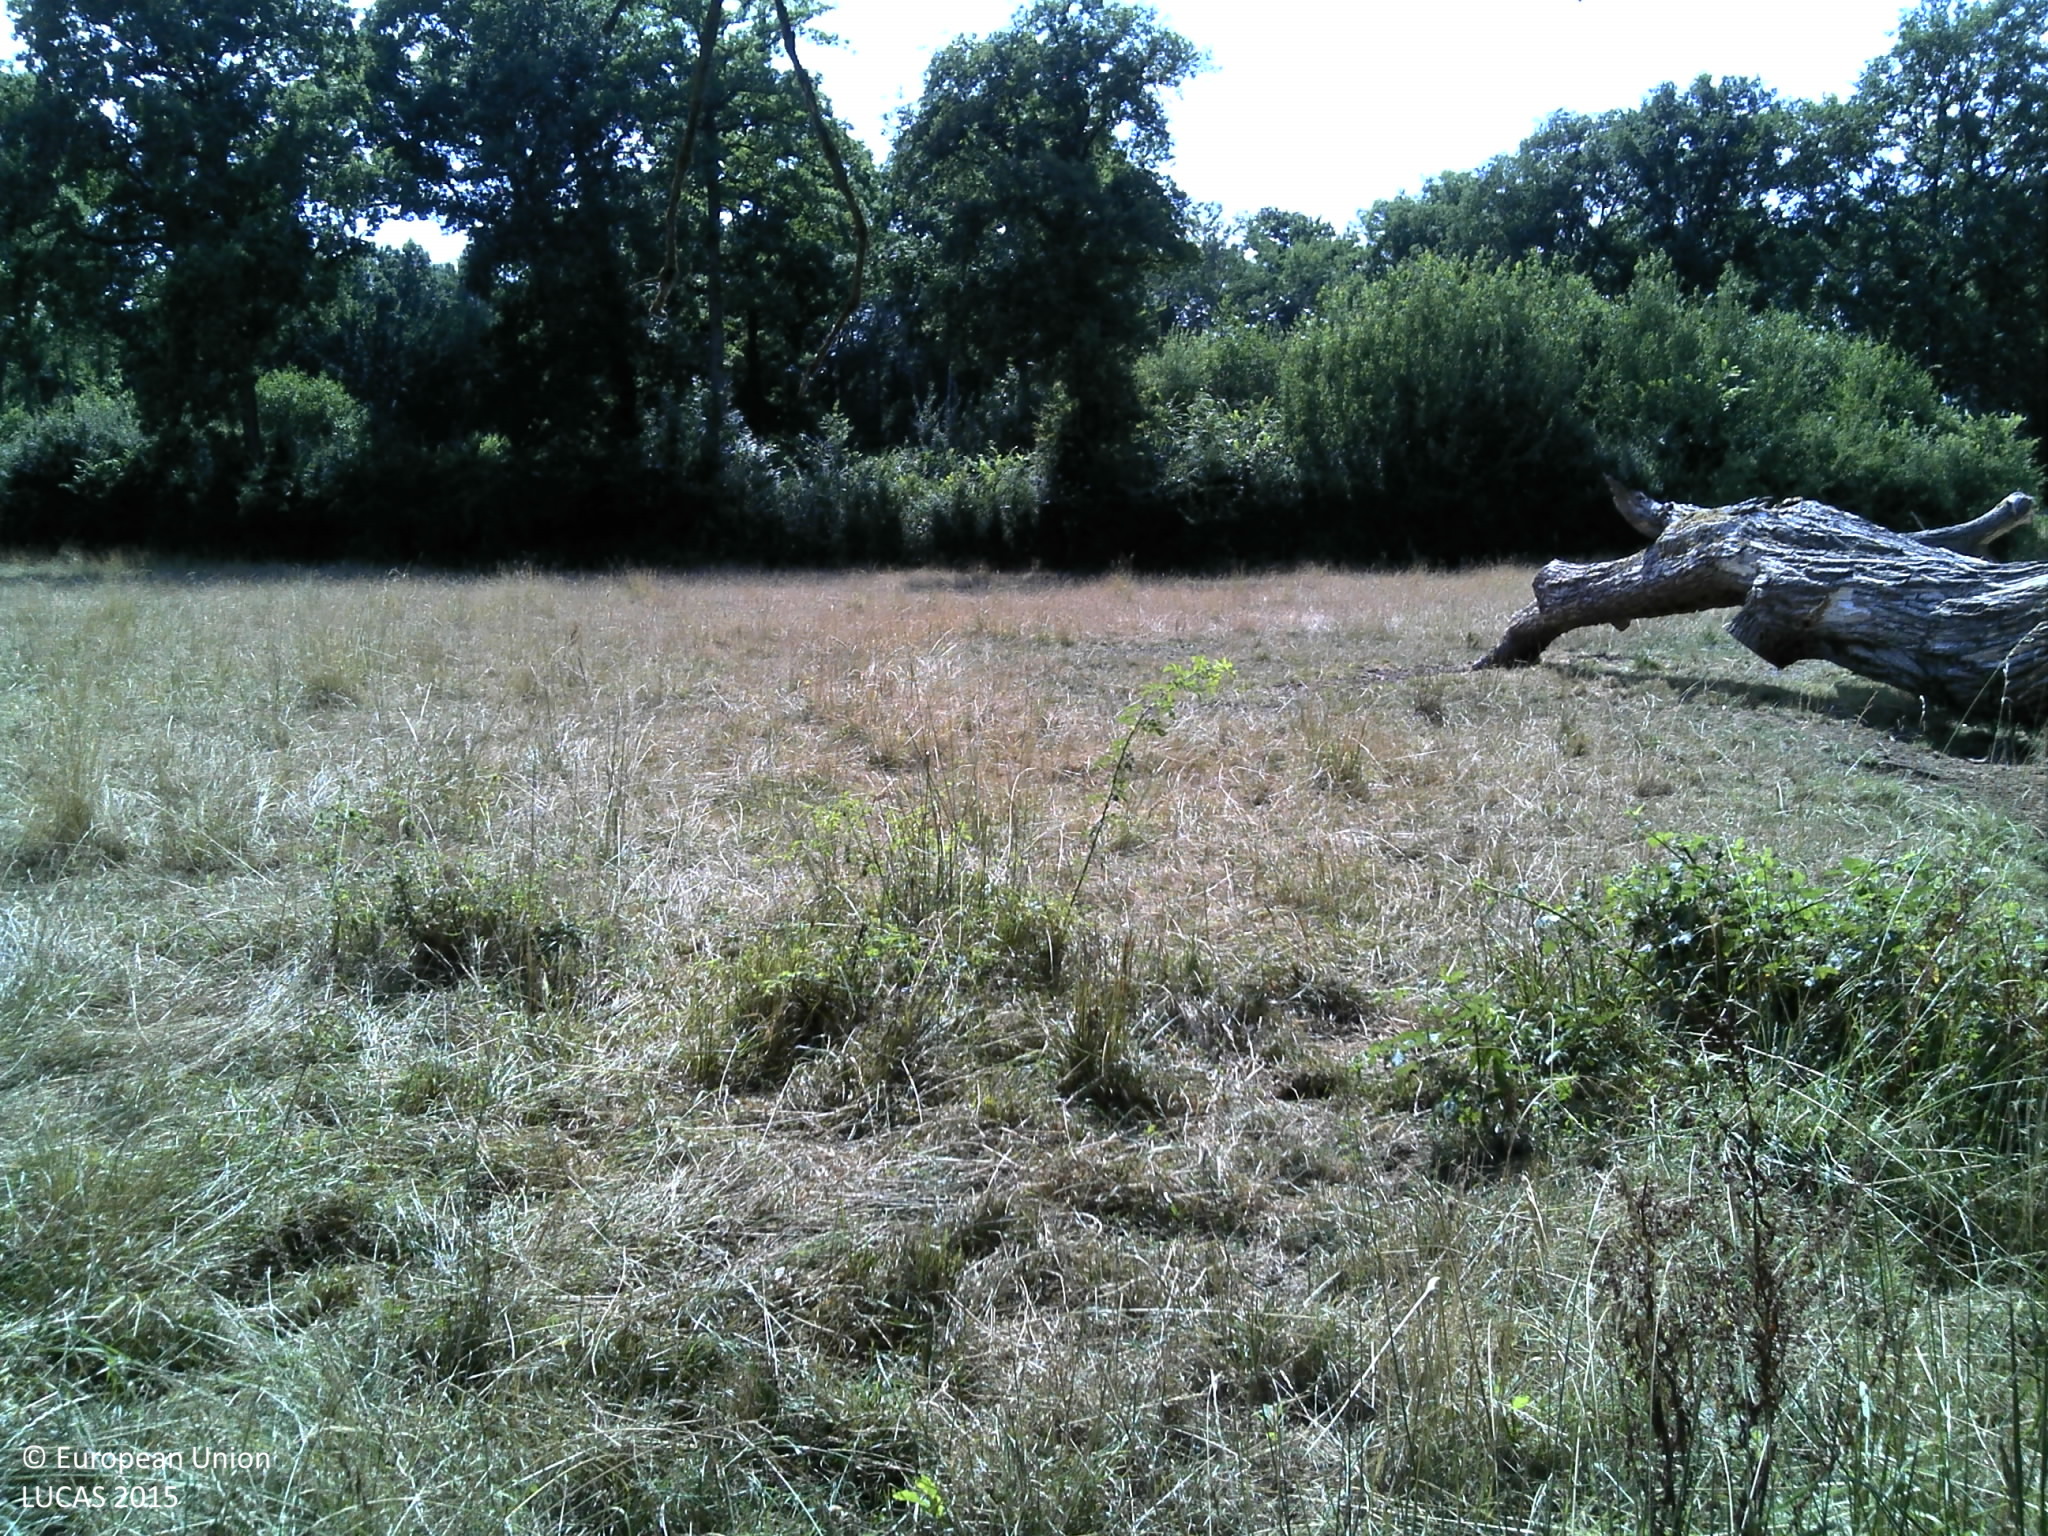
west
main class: Grassland
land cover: Grassland without tree/shrub cover
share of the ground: > 75 %
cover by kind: herbaceous plants 100 %
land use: Agriculture (excluding fallow land and kitchen gardens)
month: July
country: FR
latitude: 48.6764
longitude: 4.7690
